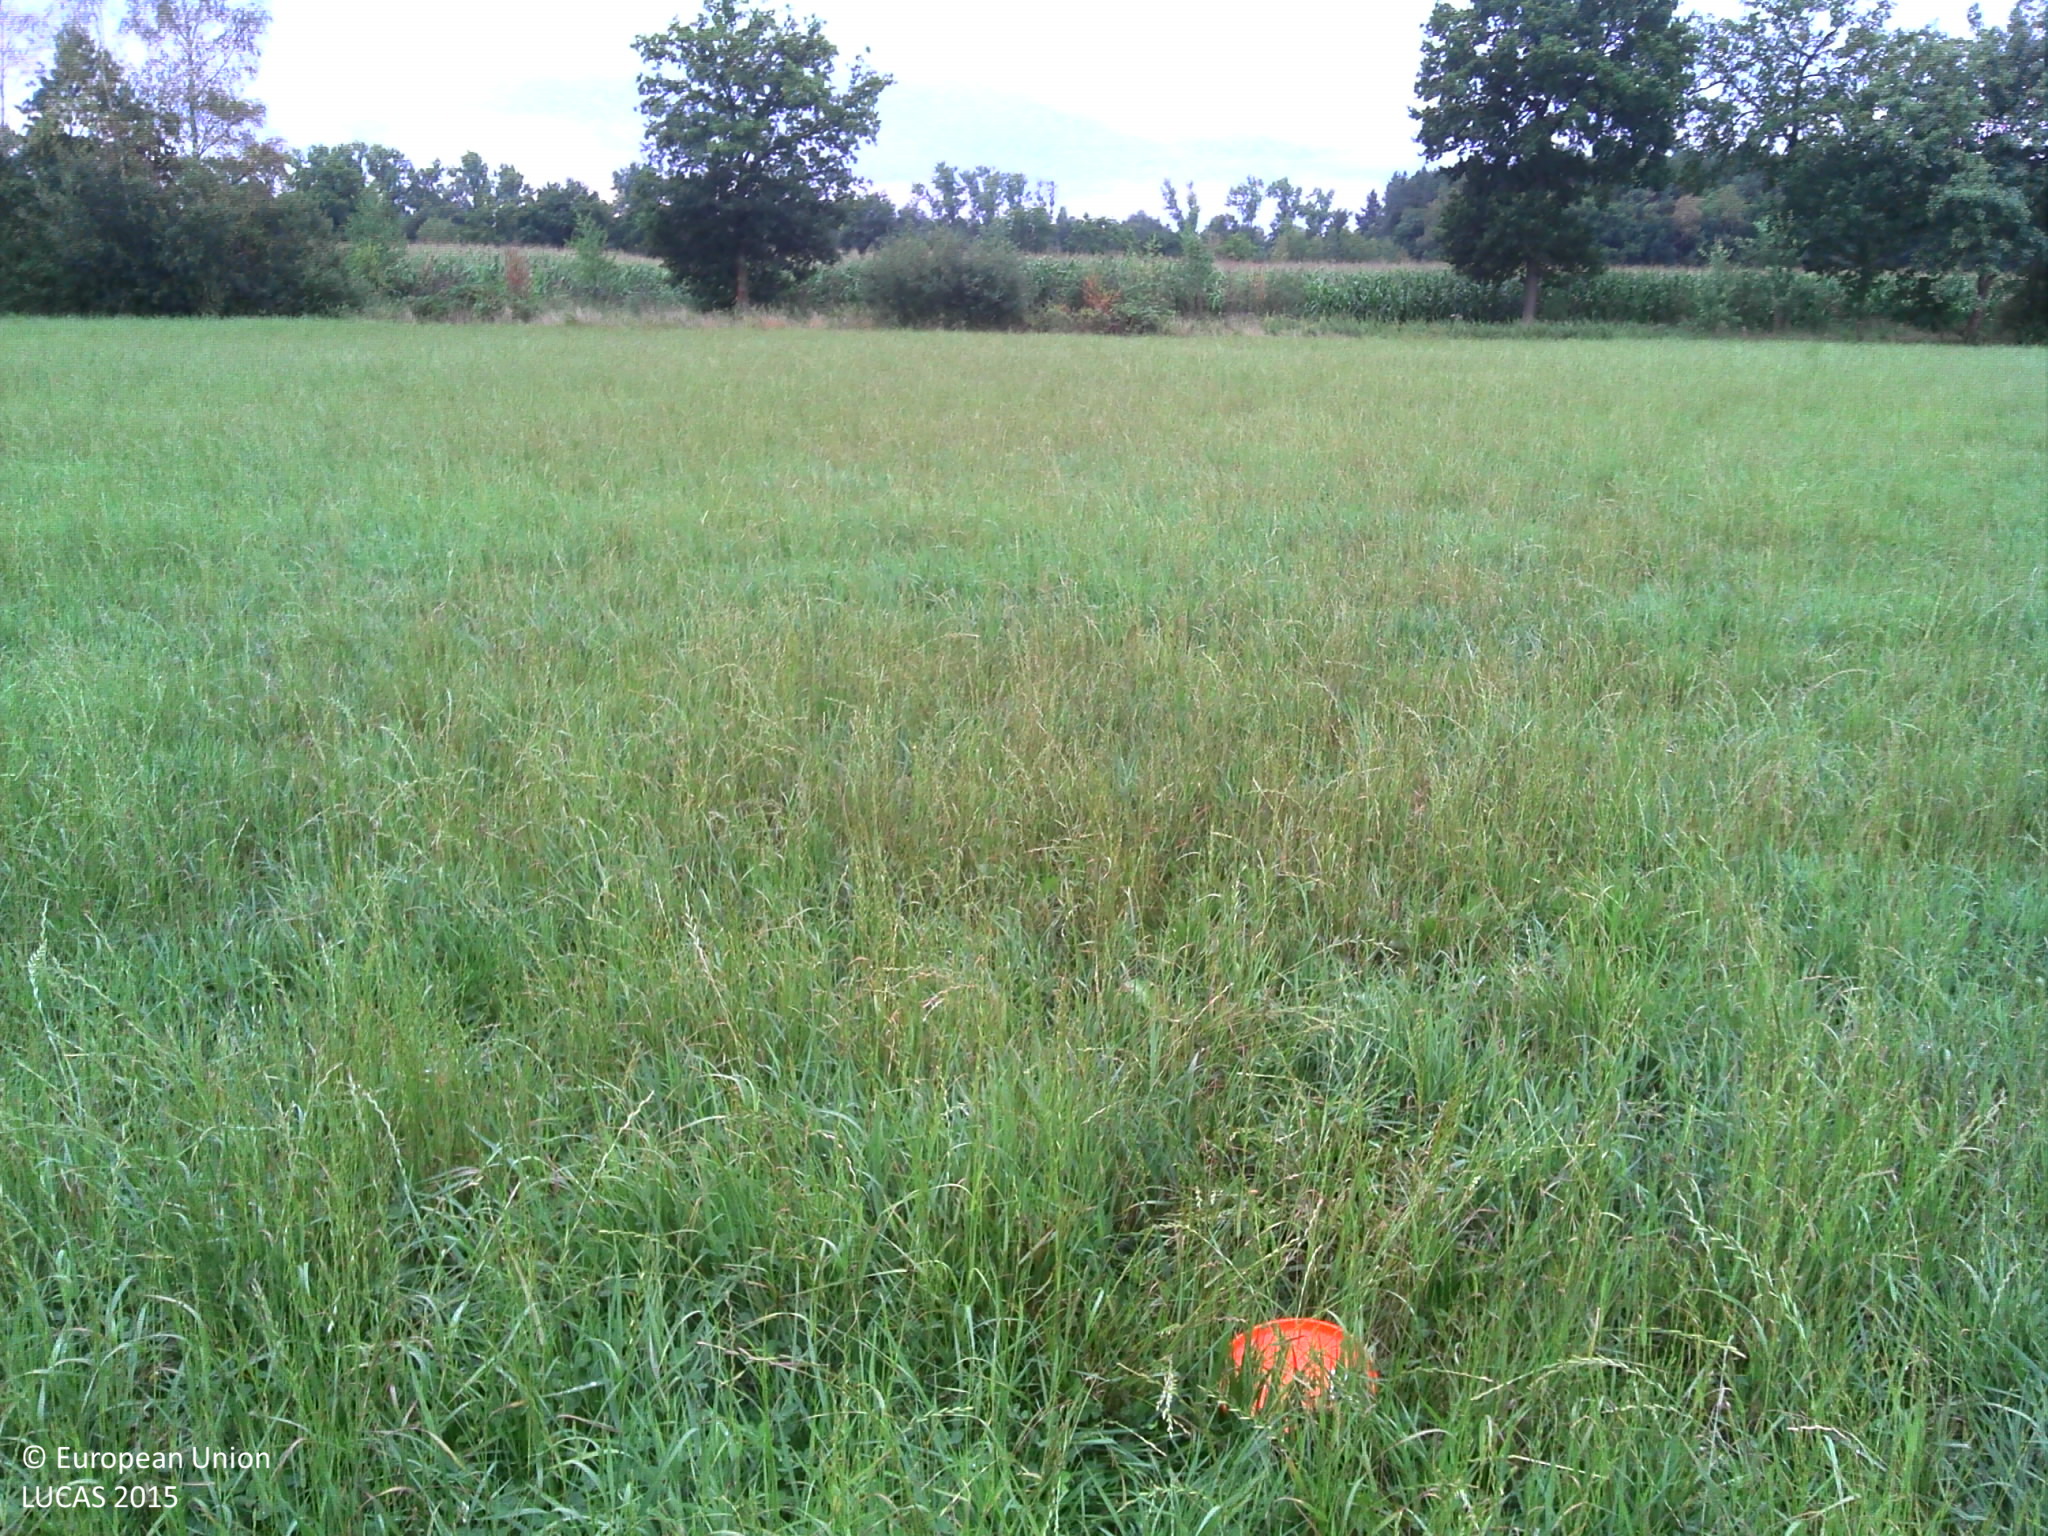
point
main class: Grassland
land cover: Grassland without tree/shrub cover
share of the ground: > 75 %
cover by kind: herbaceous plants 100 %
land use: Agriculture (excluding fallow land and kitchen gardens)
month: August
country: BE
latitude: 51.2874
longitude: 5.1366
